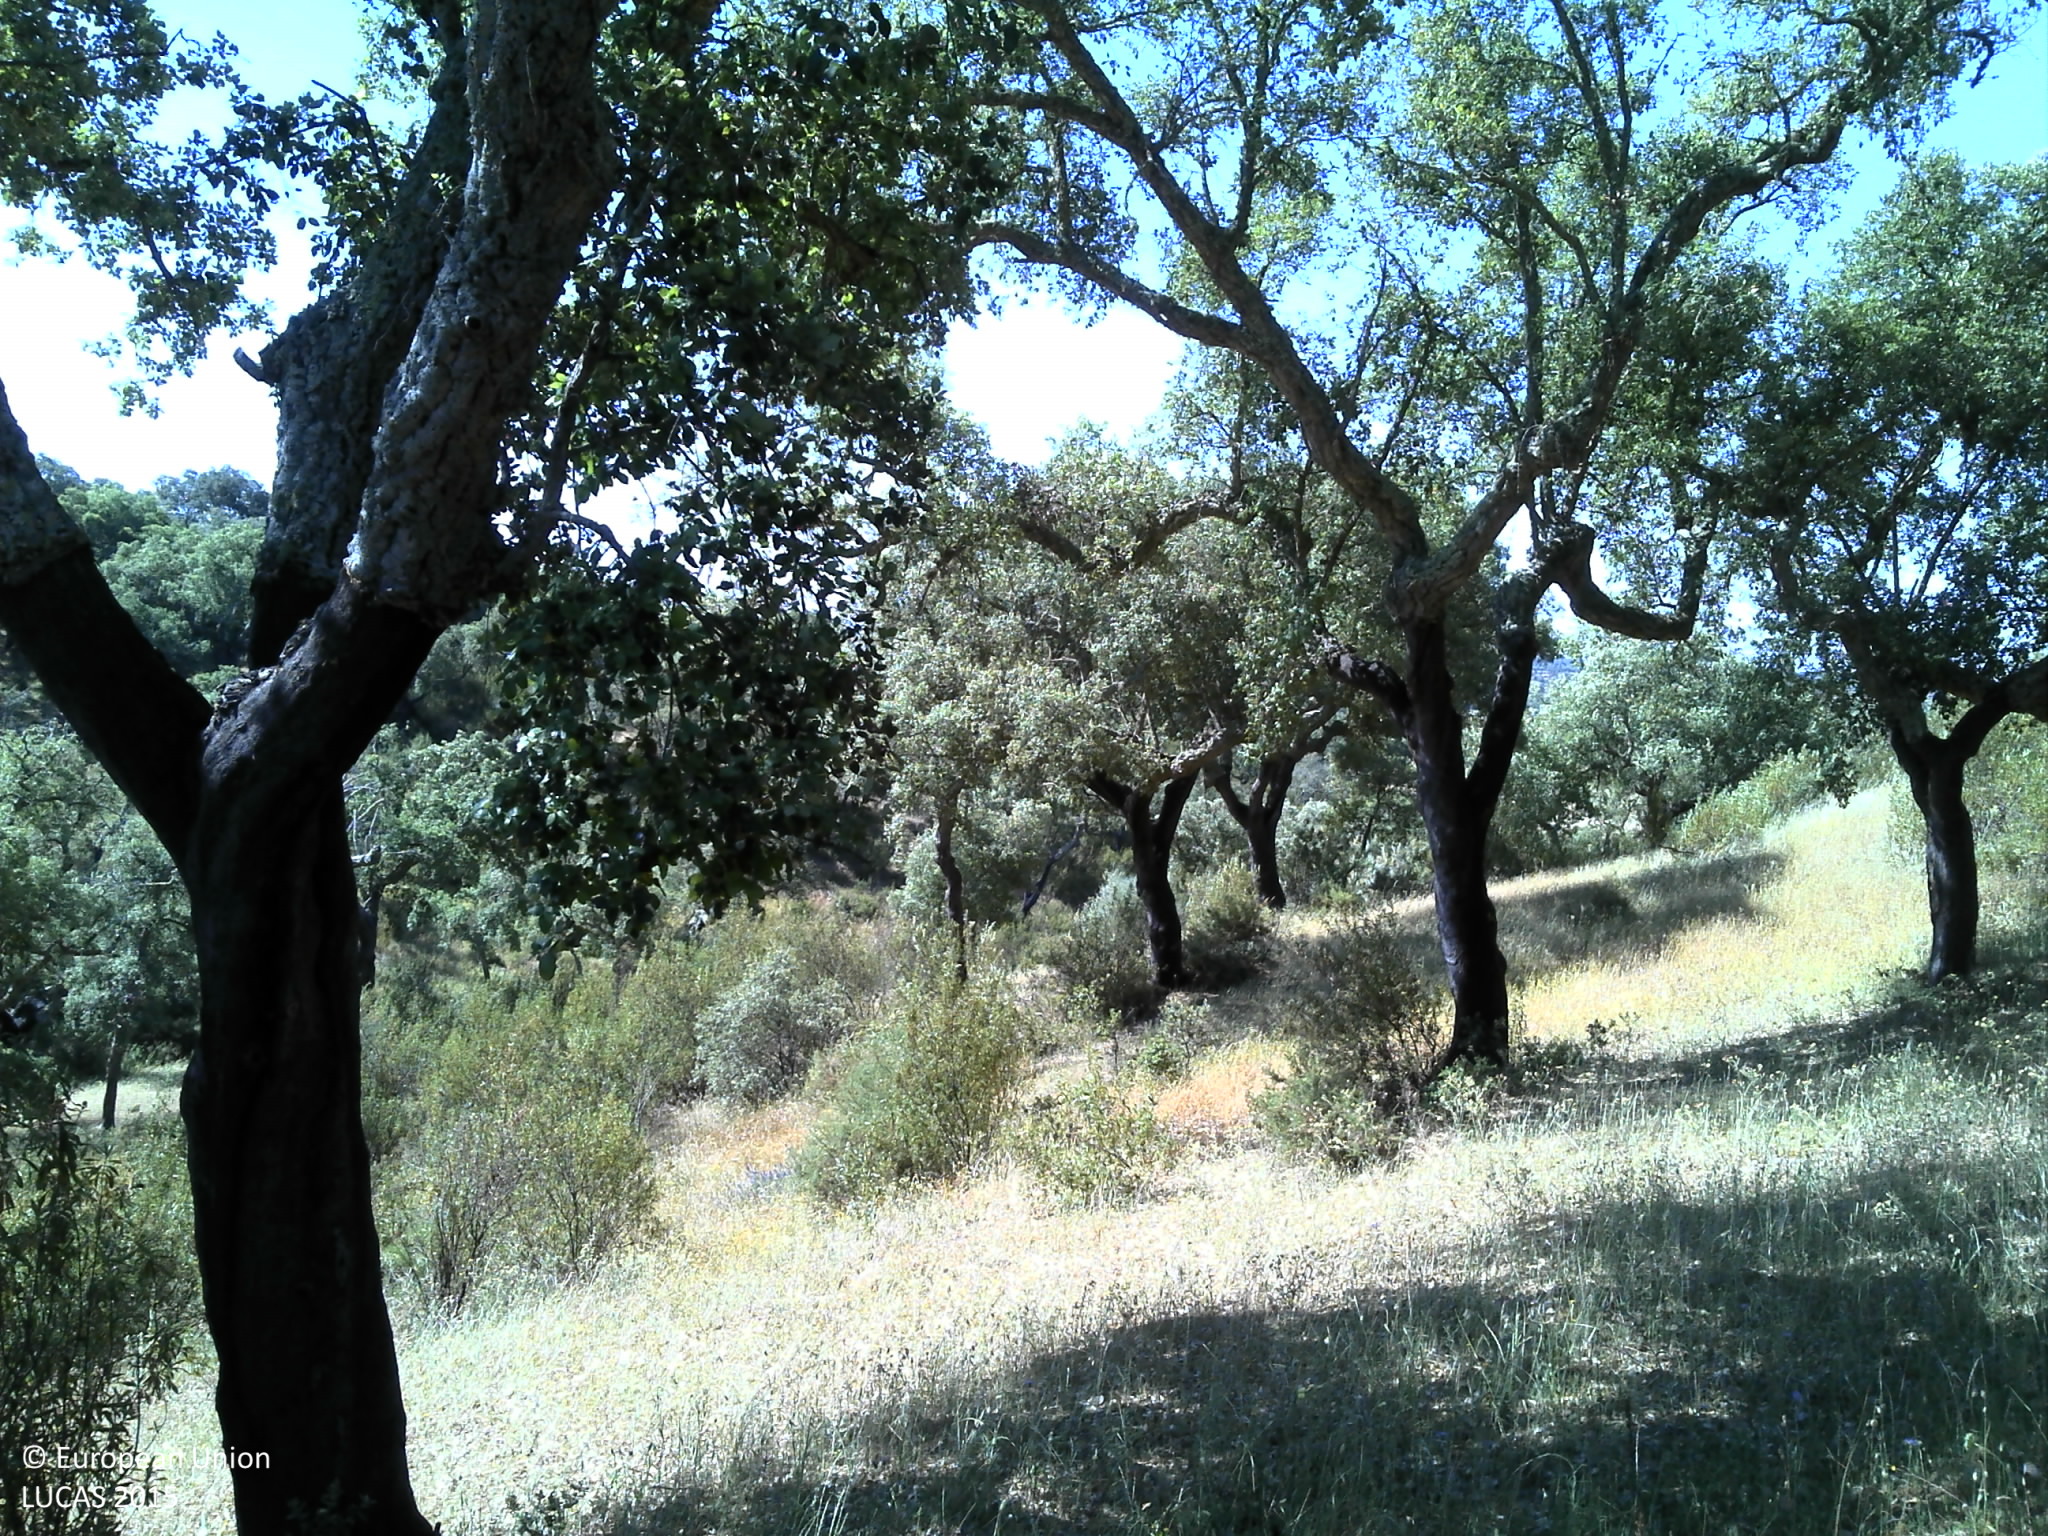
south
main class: Woodland
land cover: Broadleaved woodland
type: broadleaved evergreen forest
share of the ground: 25 - 50 %
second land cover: Shrubland without tree cover
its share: 25 - 50 %
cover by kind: broadleaved forest trees 40 %, herbaceous plants 25 %, unconsolidated bare surface 20 %, shrubs 15 %
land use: Forestry
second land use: Agriculture (excluding fallow land and kitchen gardens)
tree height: > 5 m
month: May
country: PT
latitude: 39.2201
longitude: -7.8766
